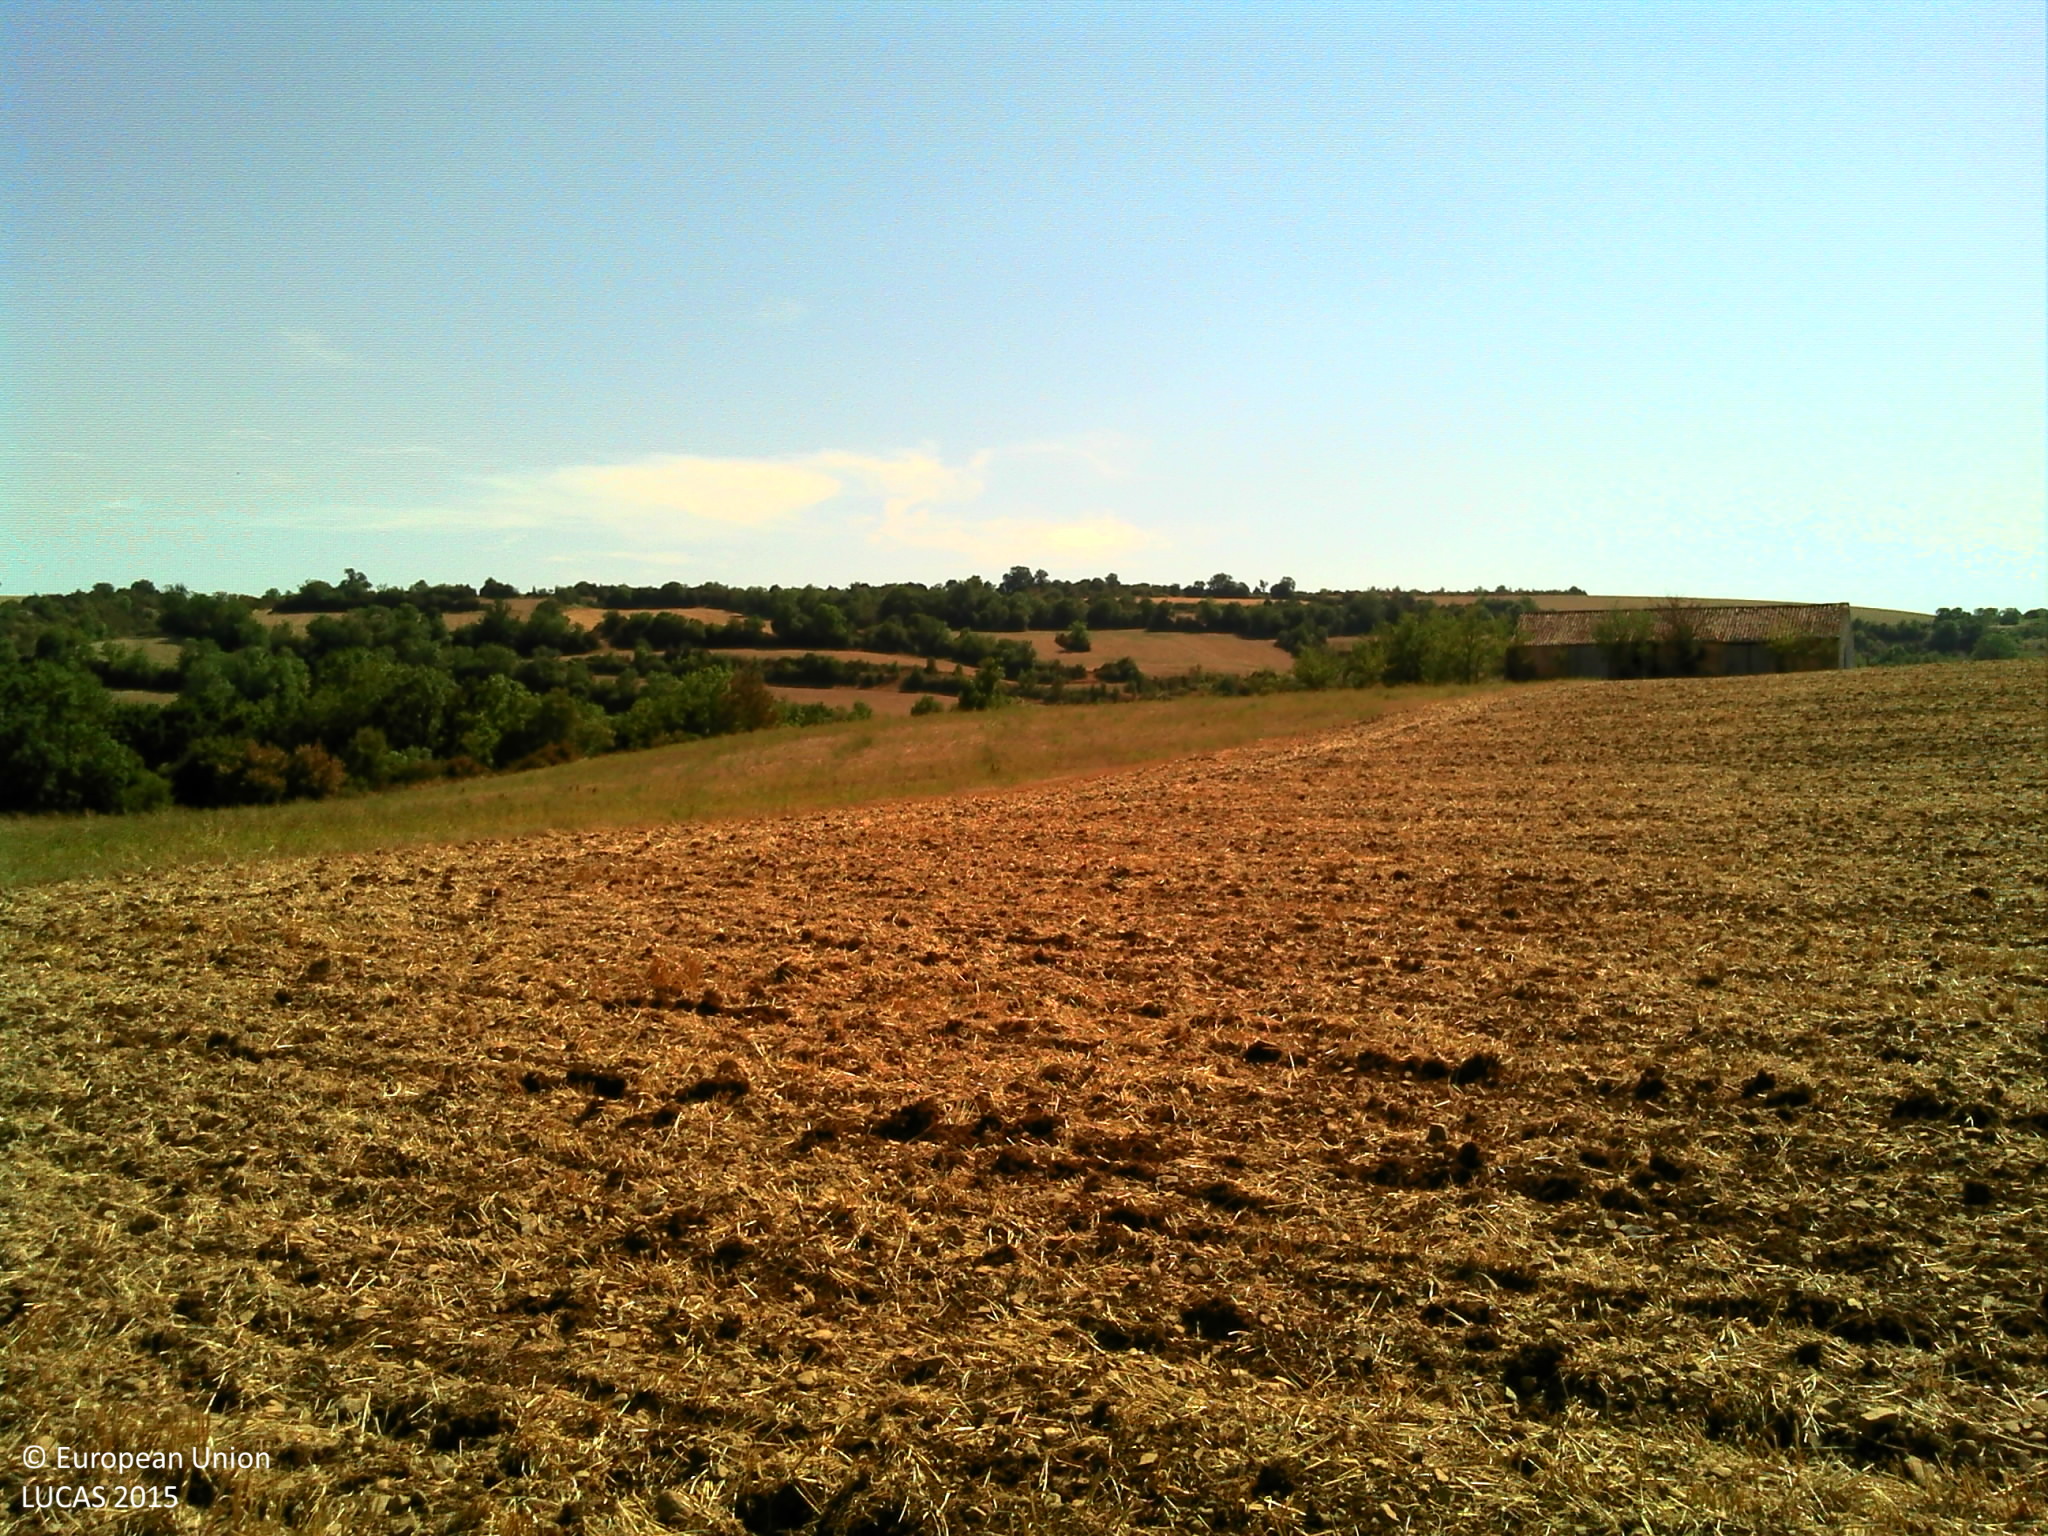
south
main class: Cropland
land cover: Barley
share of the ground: > 75 %
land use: Agriculture (excluding fallow land and kitchen gardens)
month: August
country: FR
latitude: 43.9342
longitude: 3.0180
